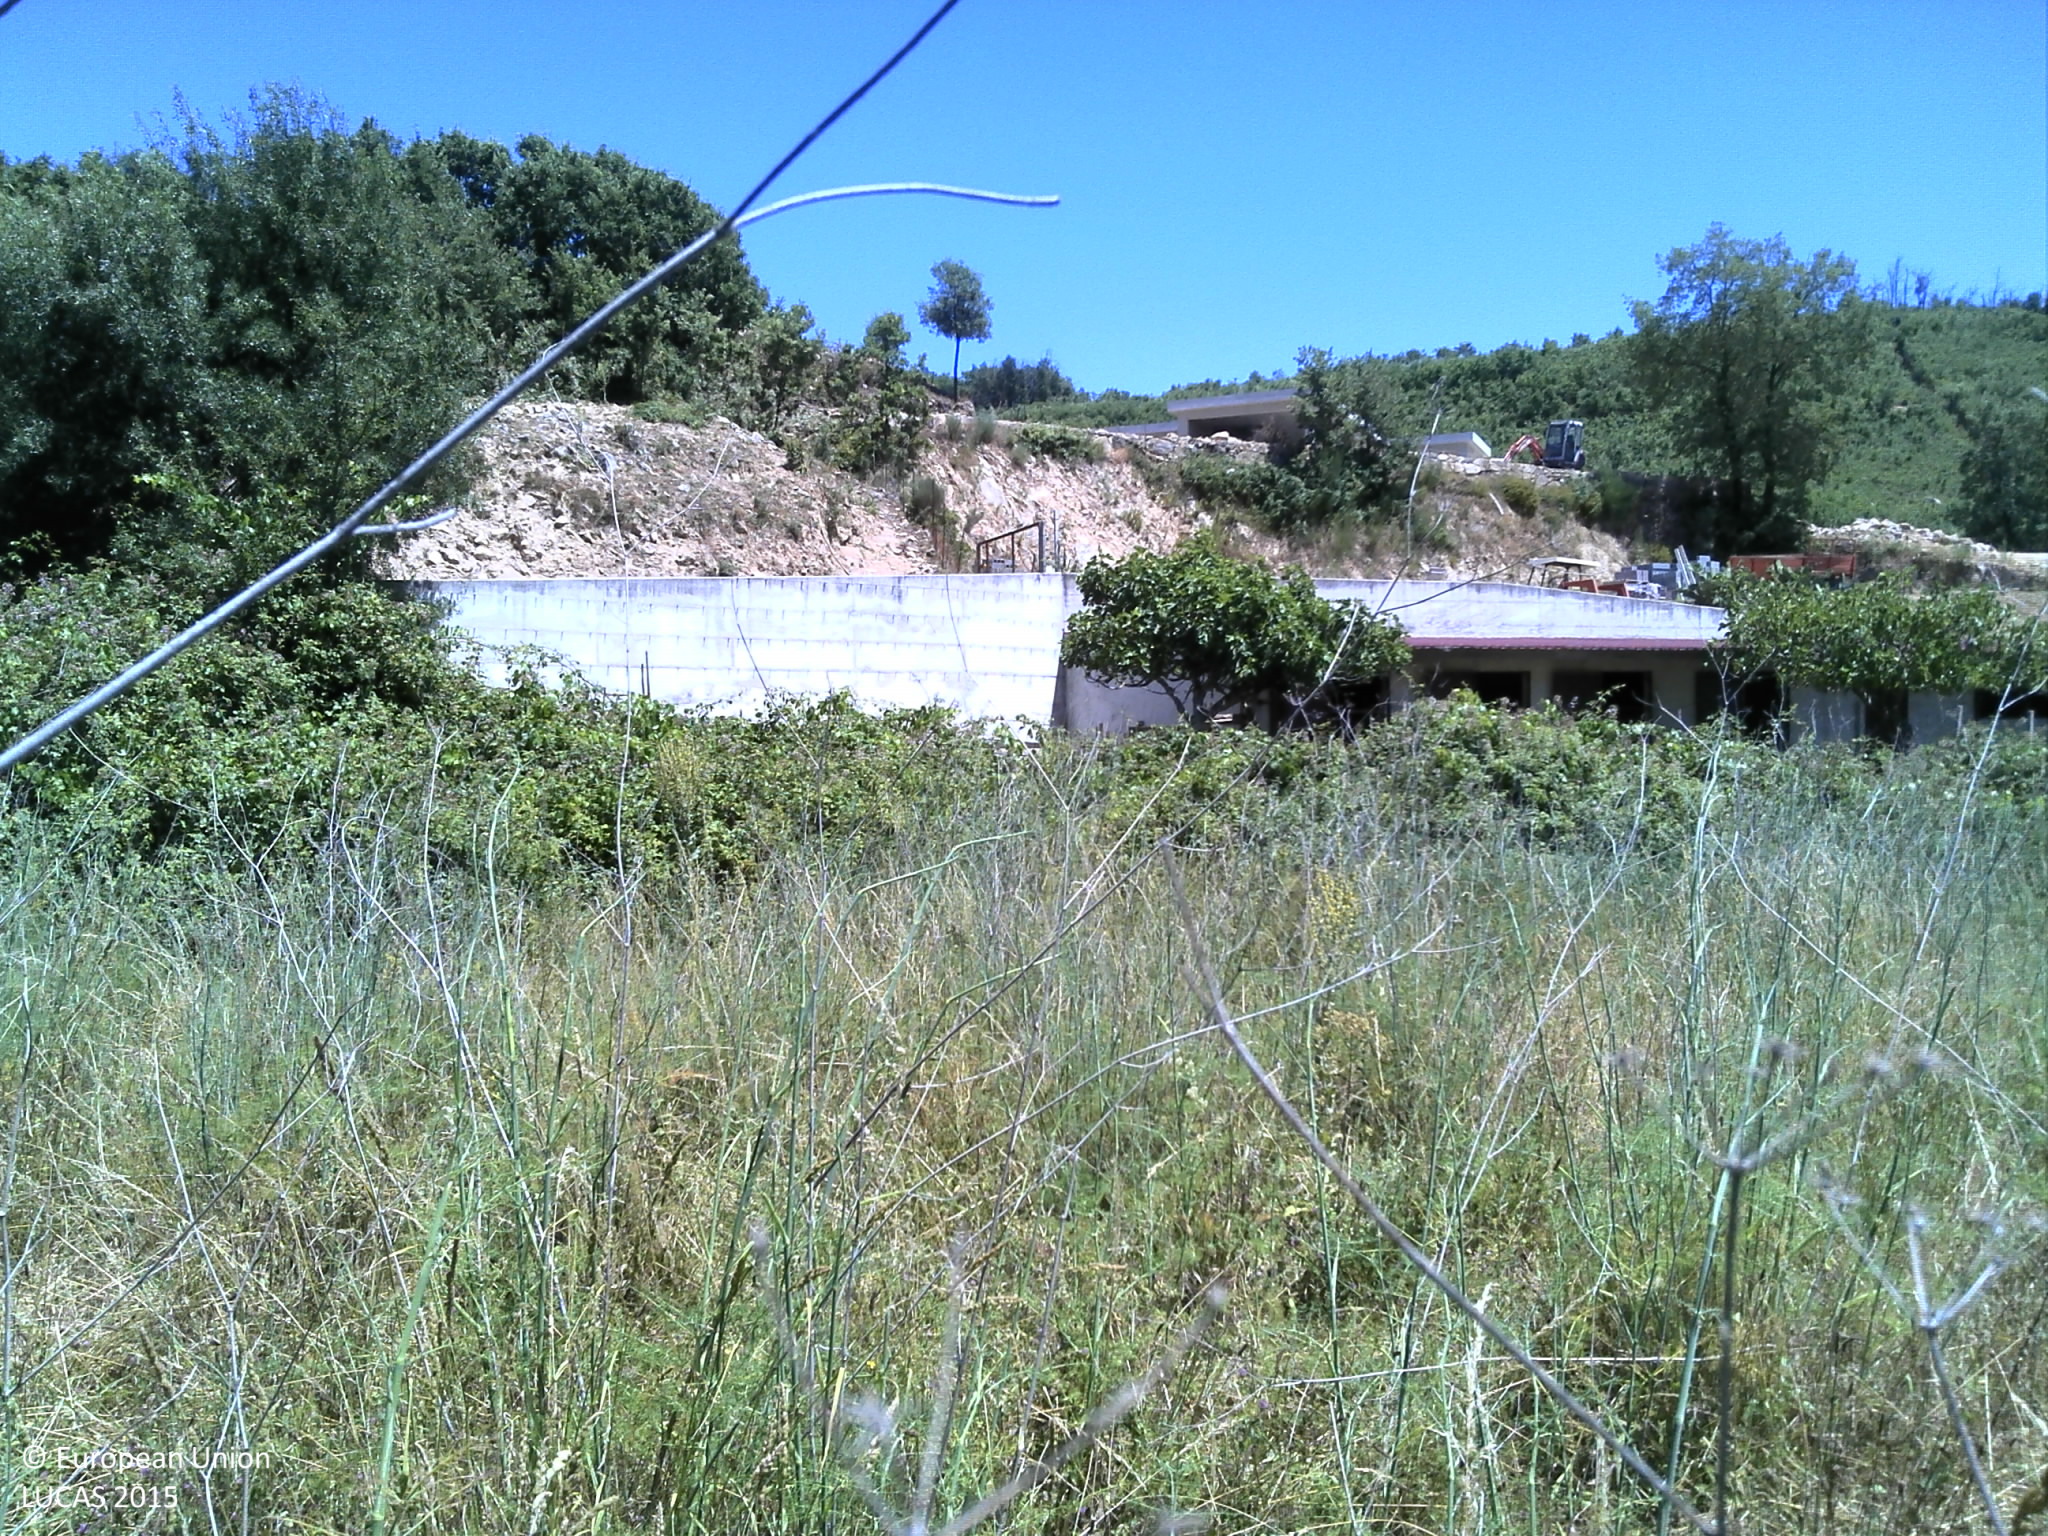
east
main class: Shrubland
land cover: Shrubland with sparse tree cover
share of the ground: > 75 %
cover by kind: shrubs 95 %, broadleaved forest trees 5 %
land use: Semi-natural and natural areas not in use
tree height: > 5 m
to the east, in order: Shrubland with sparse tree cover; Dry stone walls; Spontaneously vegetated surfaces; Shruby margins; Fences; Grassland without tree/shrub cover; Single bushes/trees; Fences; Tracks; Broadleaved woodland; Grassland with sparse tree/shrub cover; Broadleaved woodland; Tracks; Broadleaved woodland; Tracks; Shrubland with sparse tree cover; Arable land (only in case pi)
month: June
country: PT
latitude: 40.7432
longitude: -7.3179
